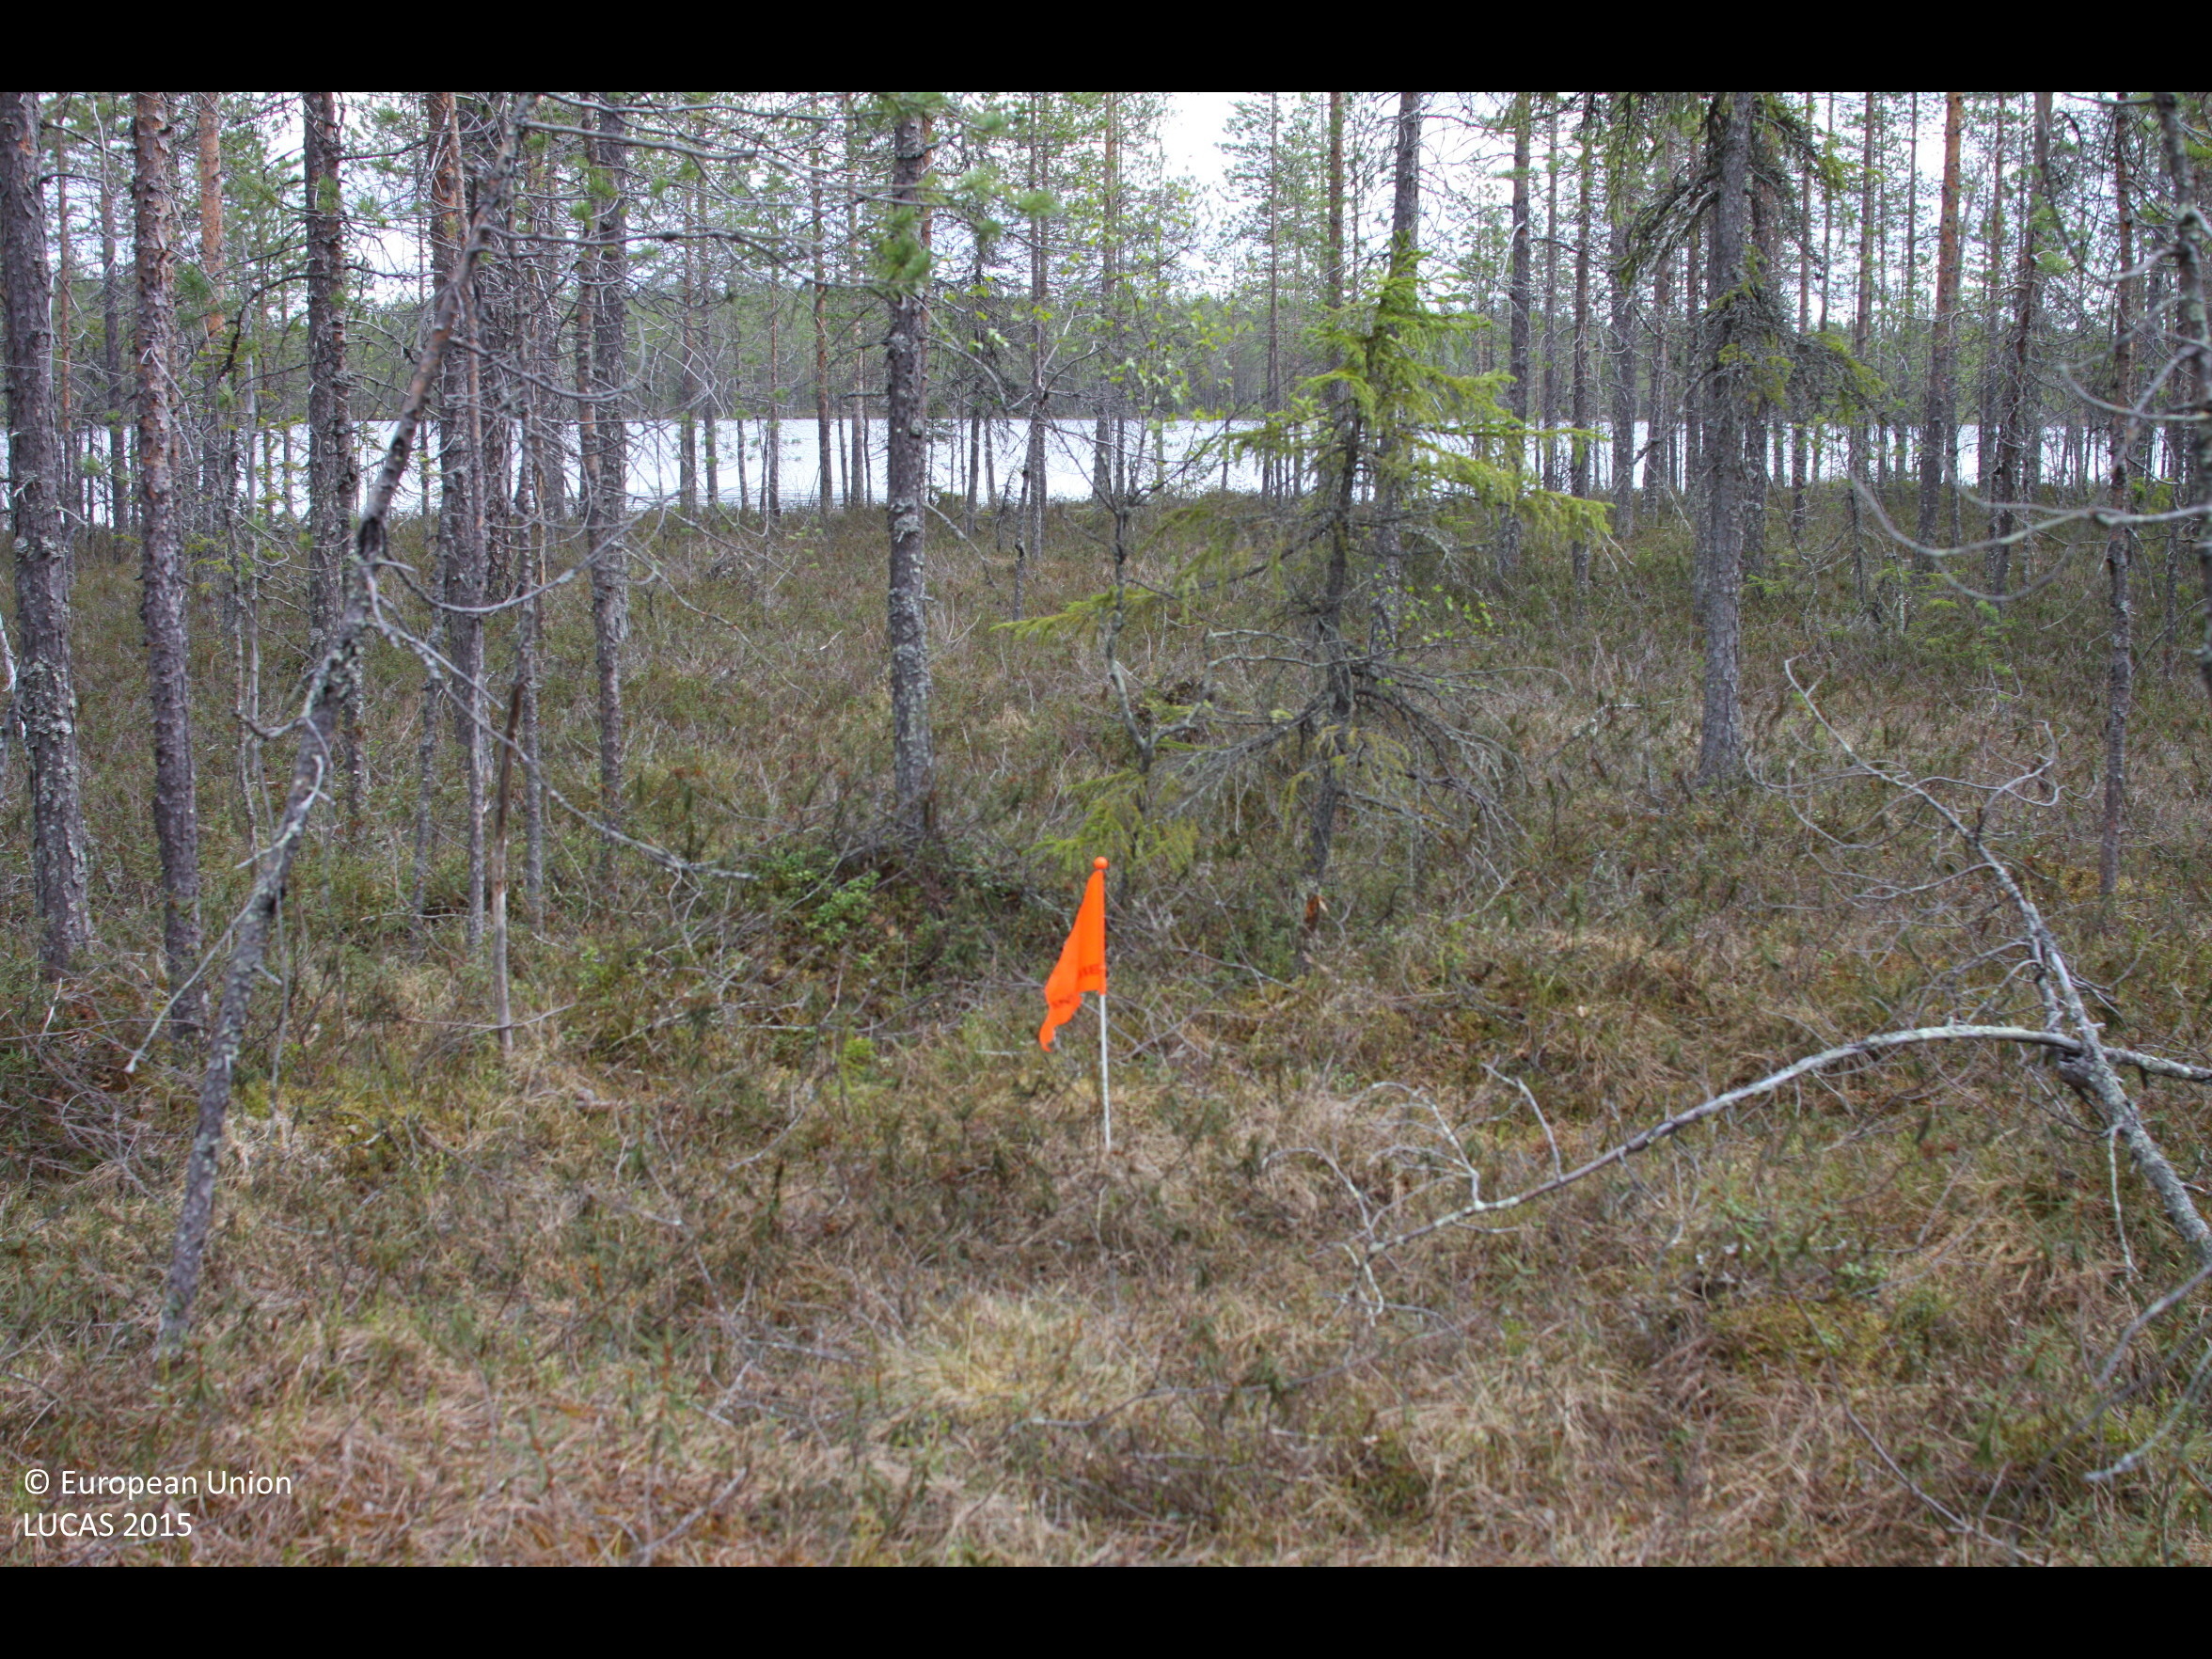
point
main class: Woodland
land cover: Pine dominated coniferous woodland
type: boreal forest
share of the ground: 50 - 75 %
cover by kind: coniferous forest trees 65 %, shrubs 25 %, herbaceous plants 5 %, lichens and mosses 5 %
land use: Forestry
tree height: > 5 m
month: June
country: FI
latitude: 66.2052
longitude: 27.8776
